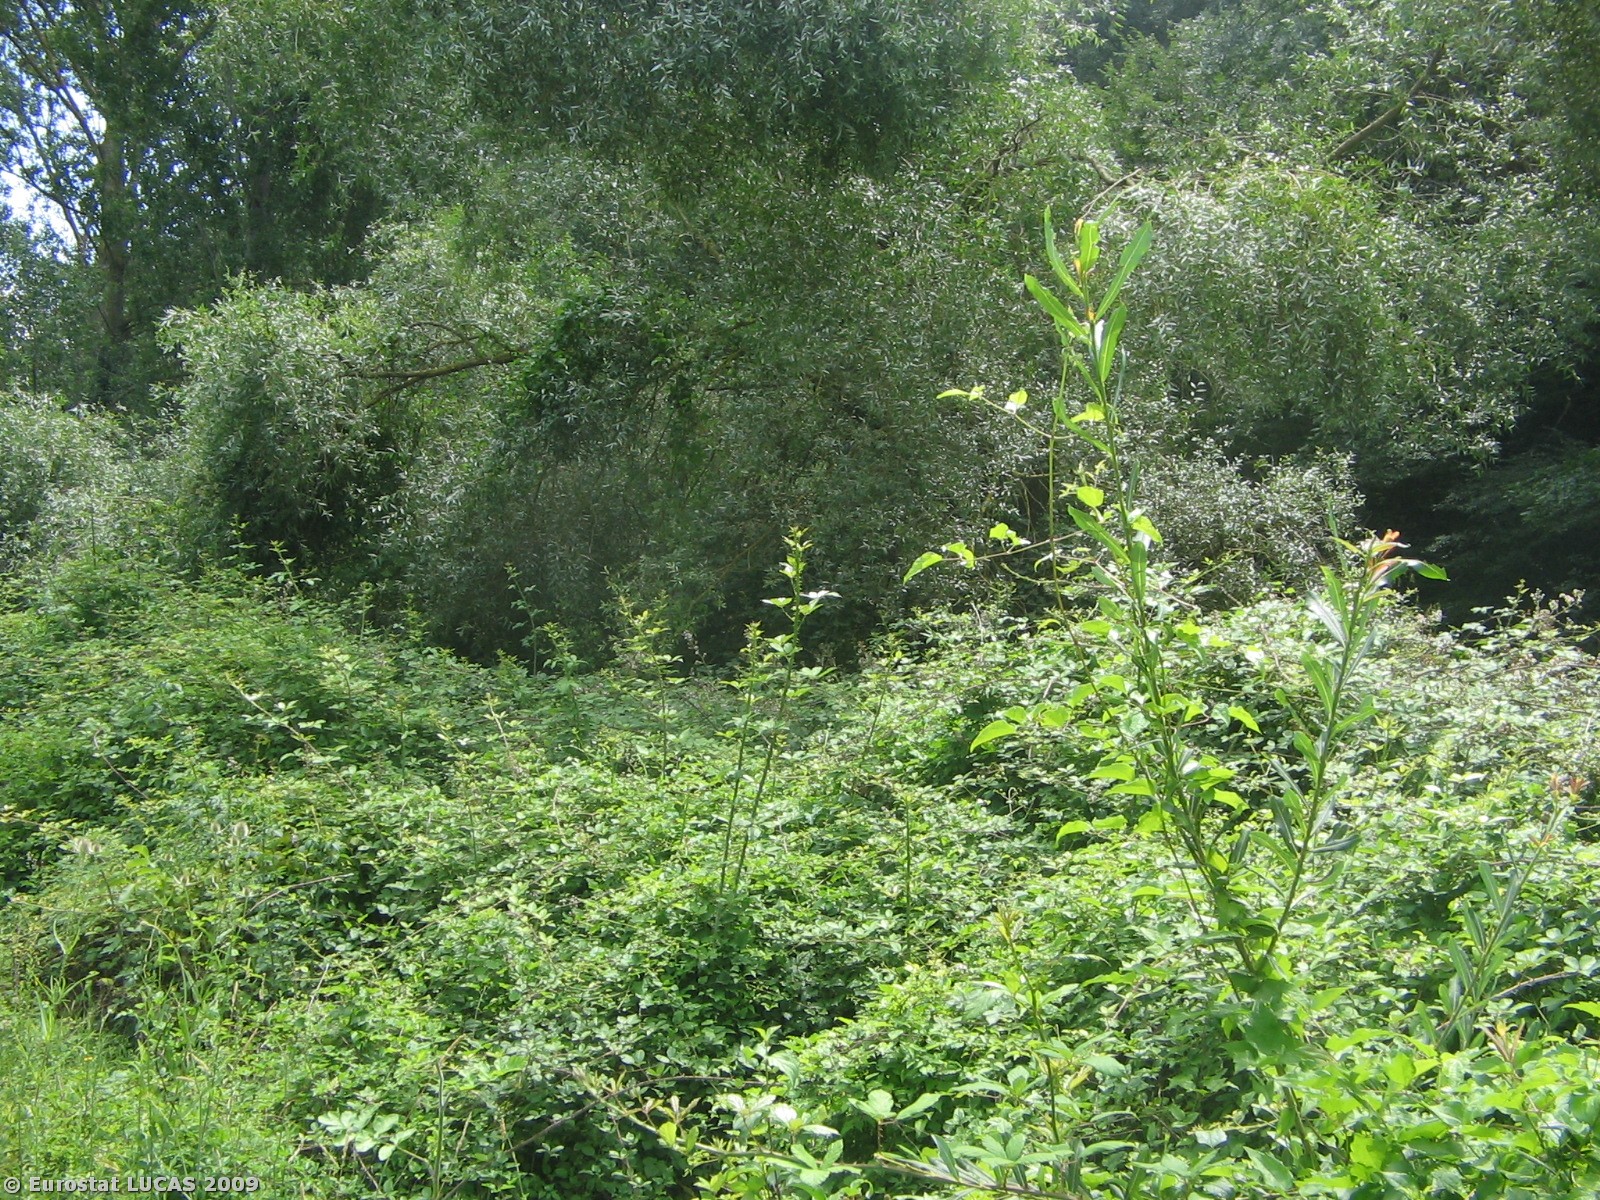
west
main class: Woodland
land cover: Broadleaved woodland
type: thermophilous deciduous forest
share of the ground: > 75 %
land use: Forestry
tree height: > 5 m
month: July
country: IT
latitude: 42.2160
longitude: 12.8612
